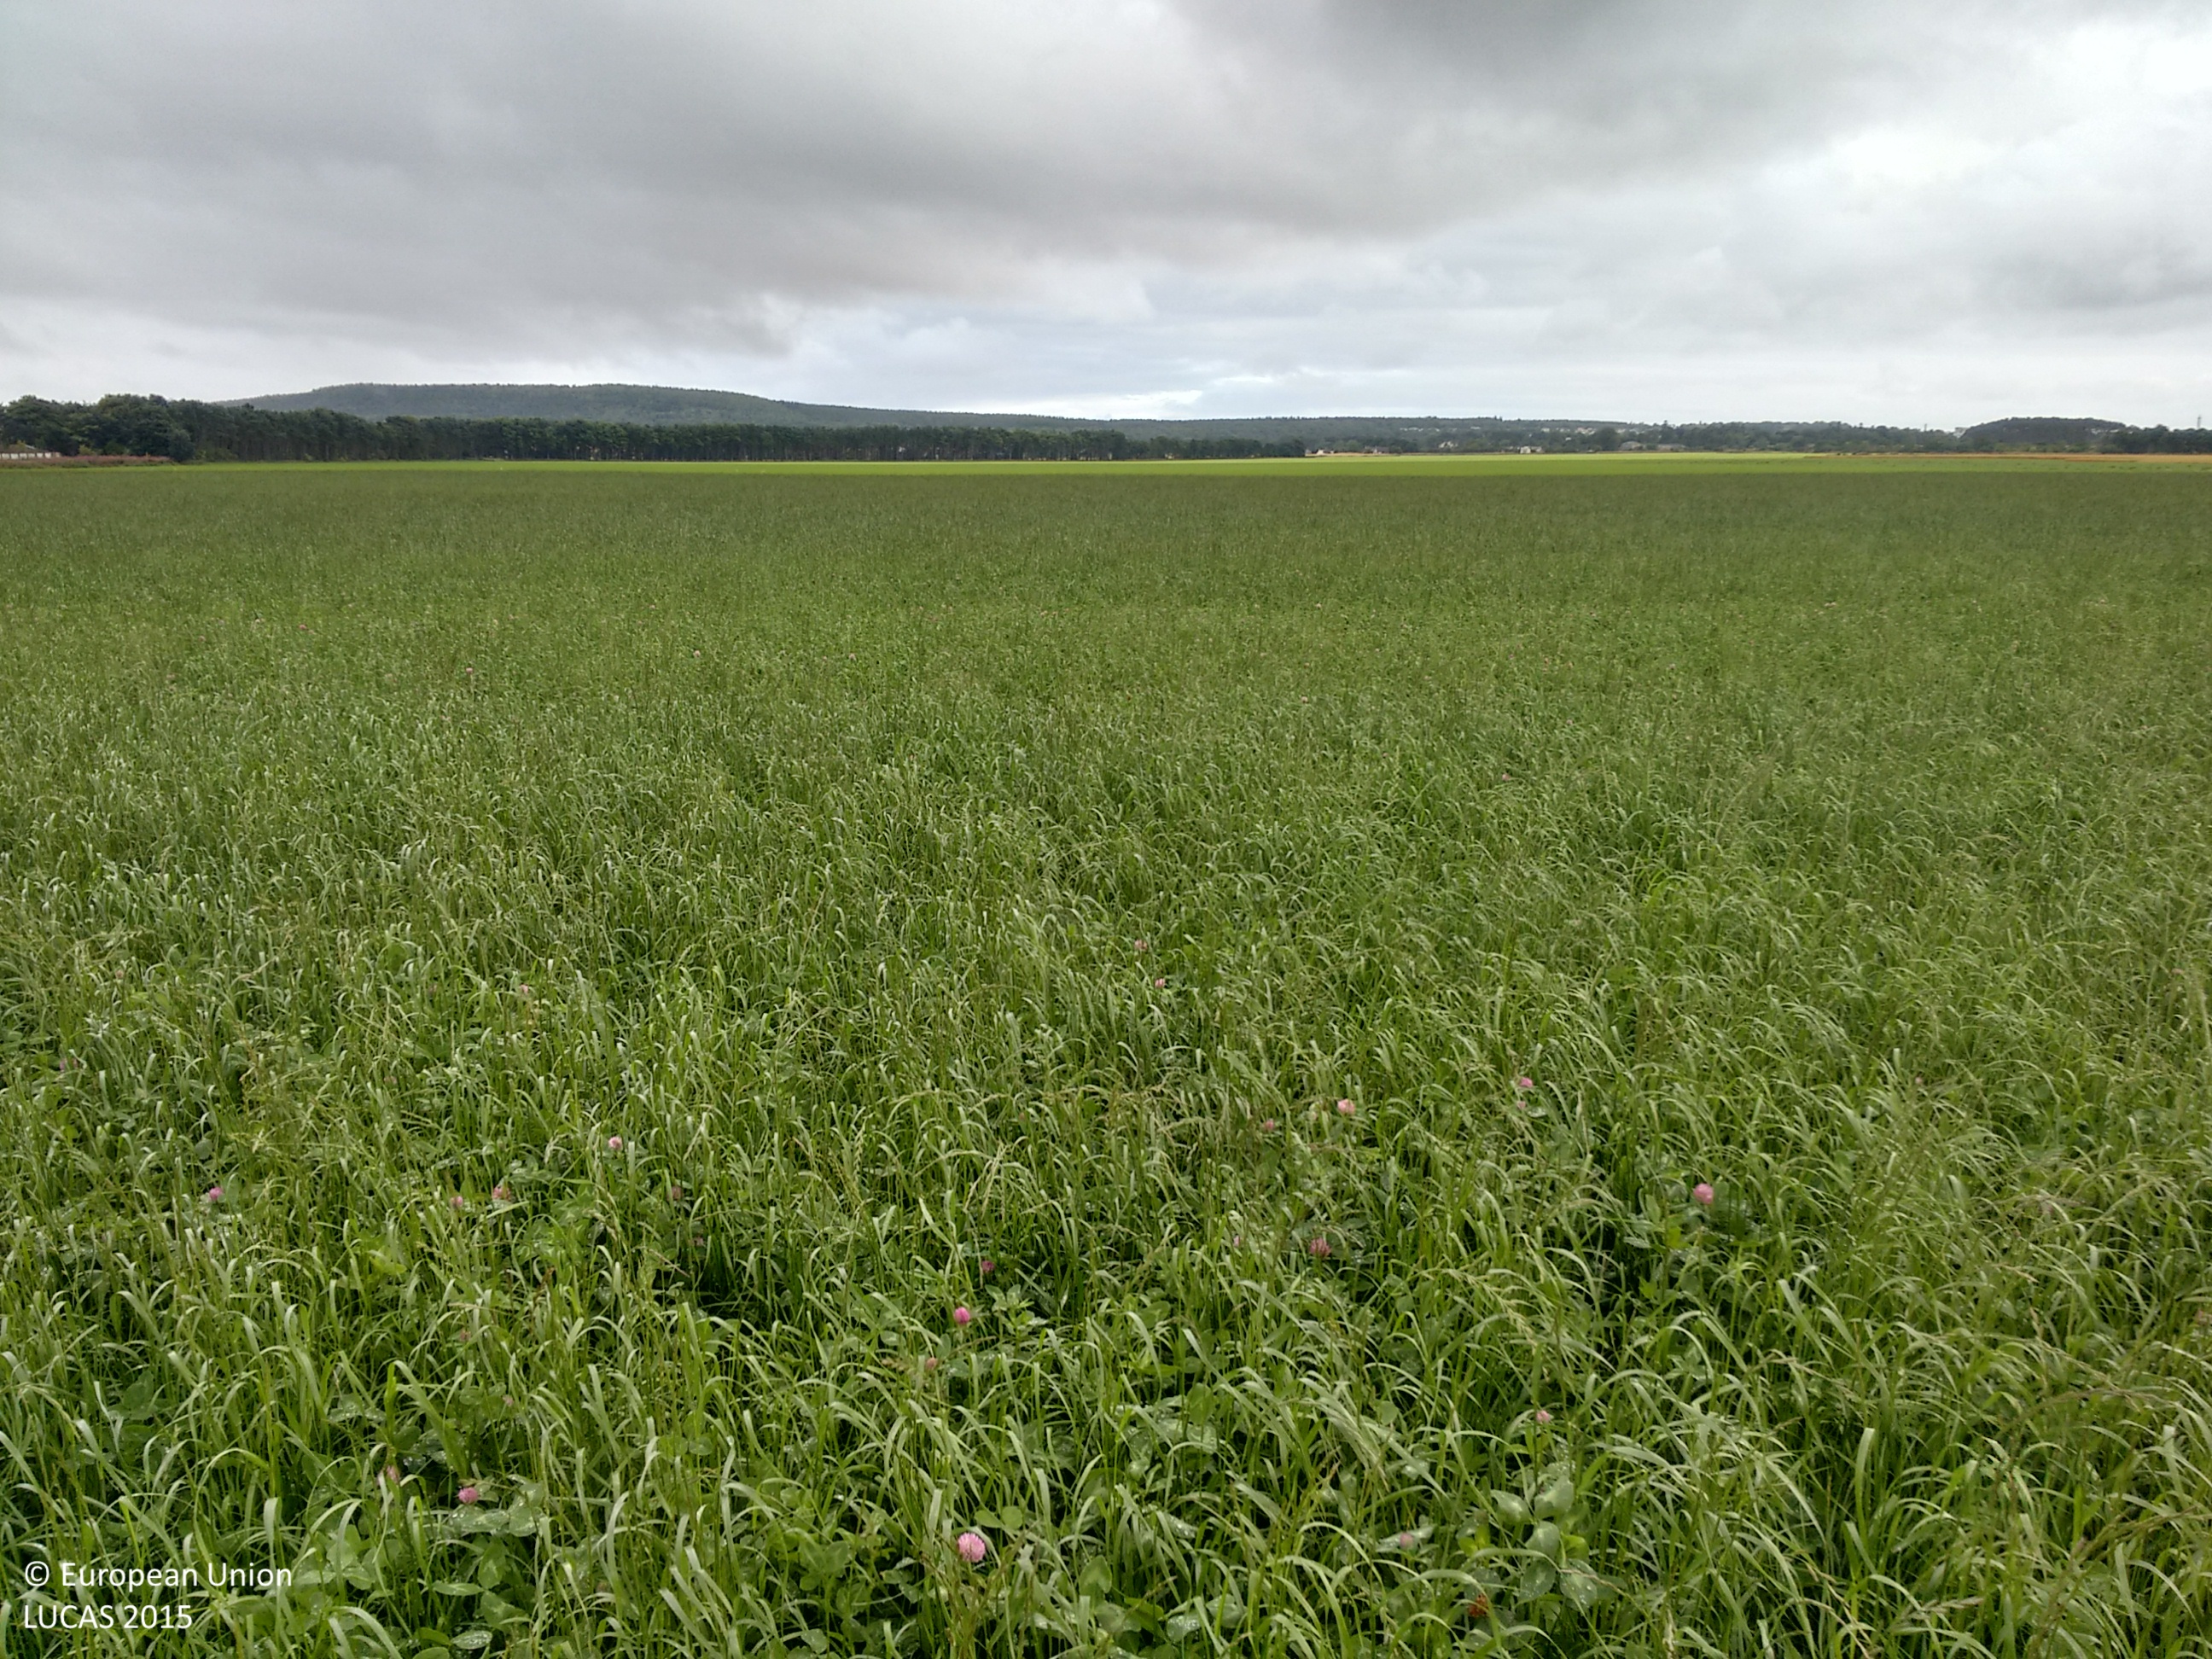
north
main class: Cropland
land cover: Temporary grasslands
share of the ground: > 75 %
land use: Agriculture (excluding fallow land and kitchen gardens)
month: September
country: GB
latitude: 57.6231
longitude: -3.3445
